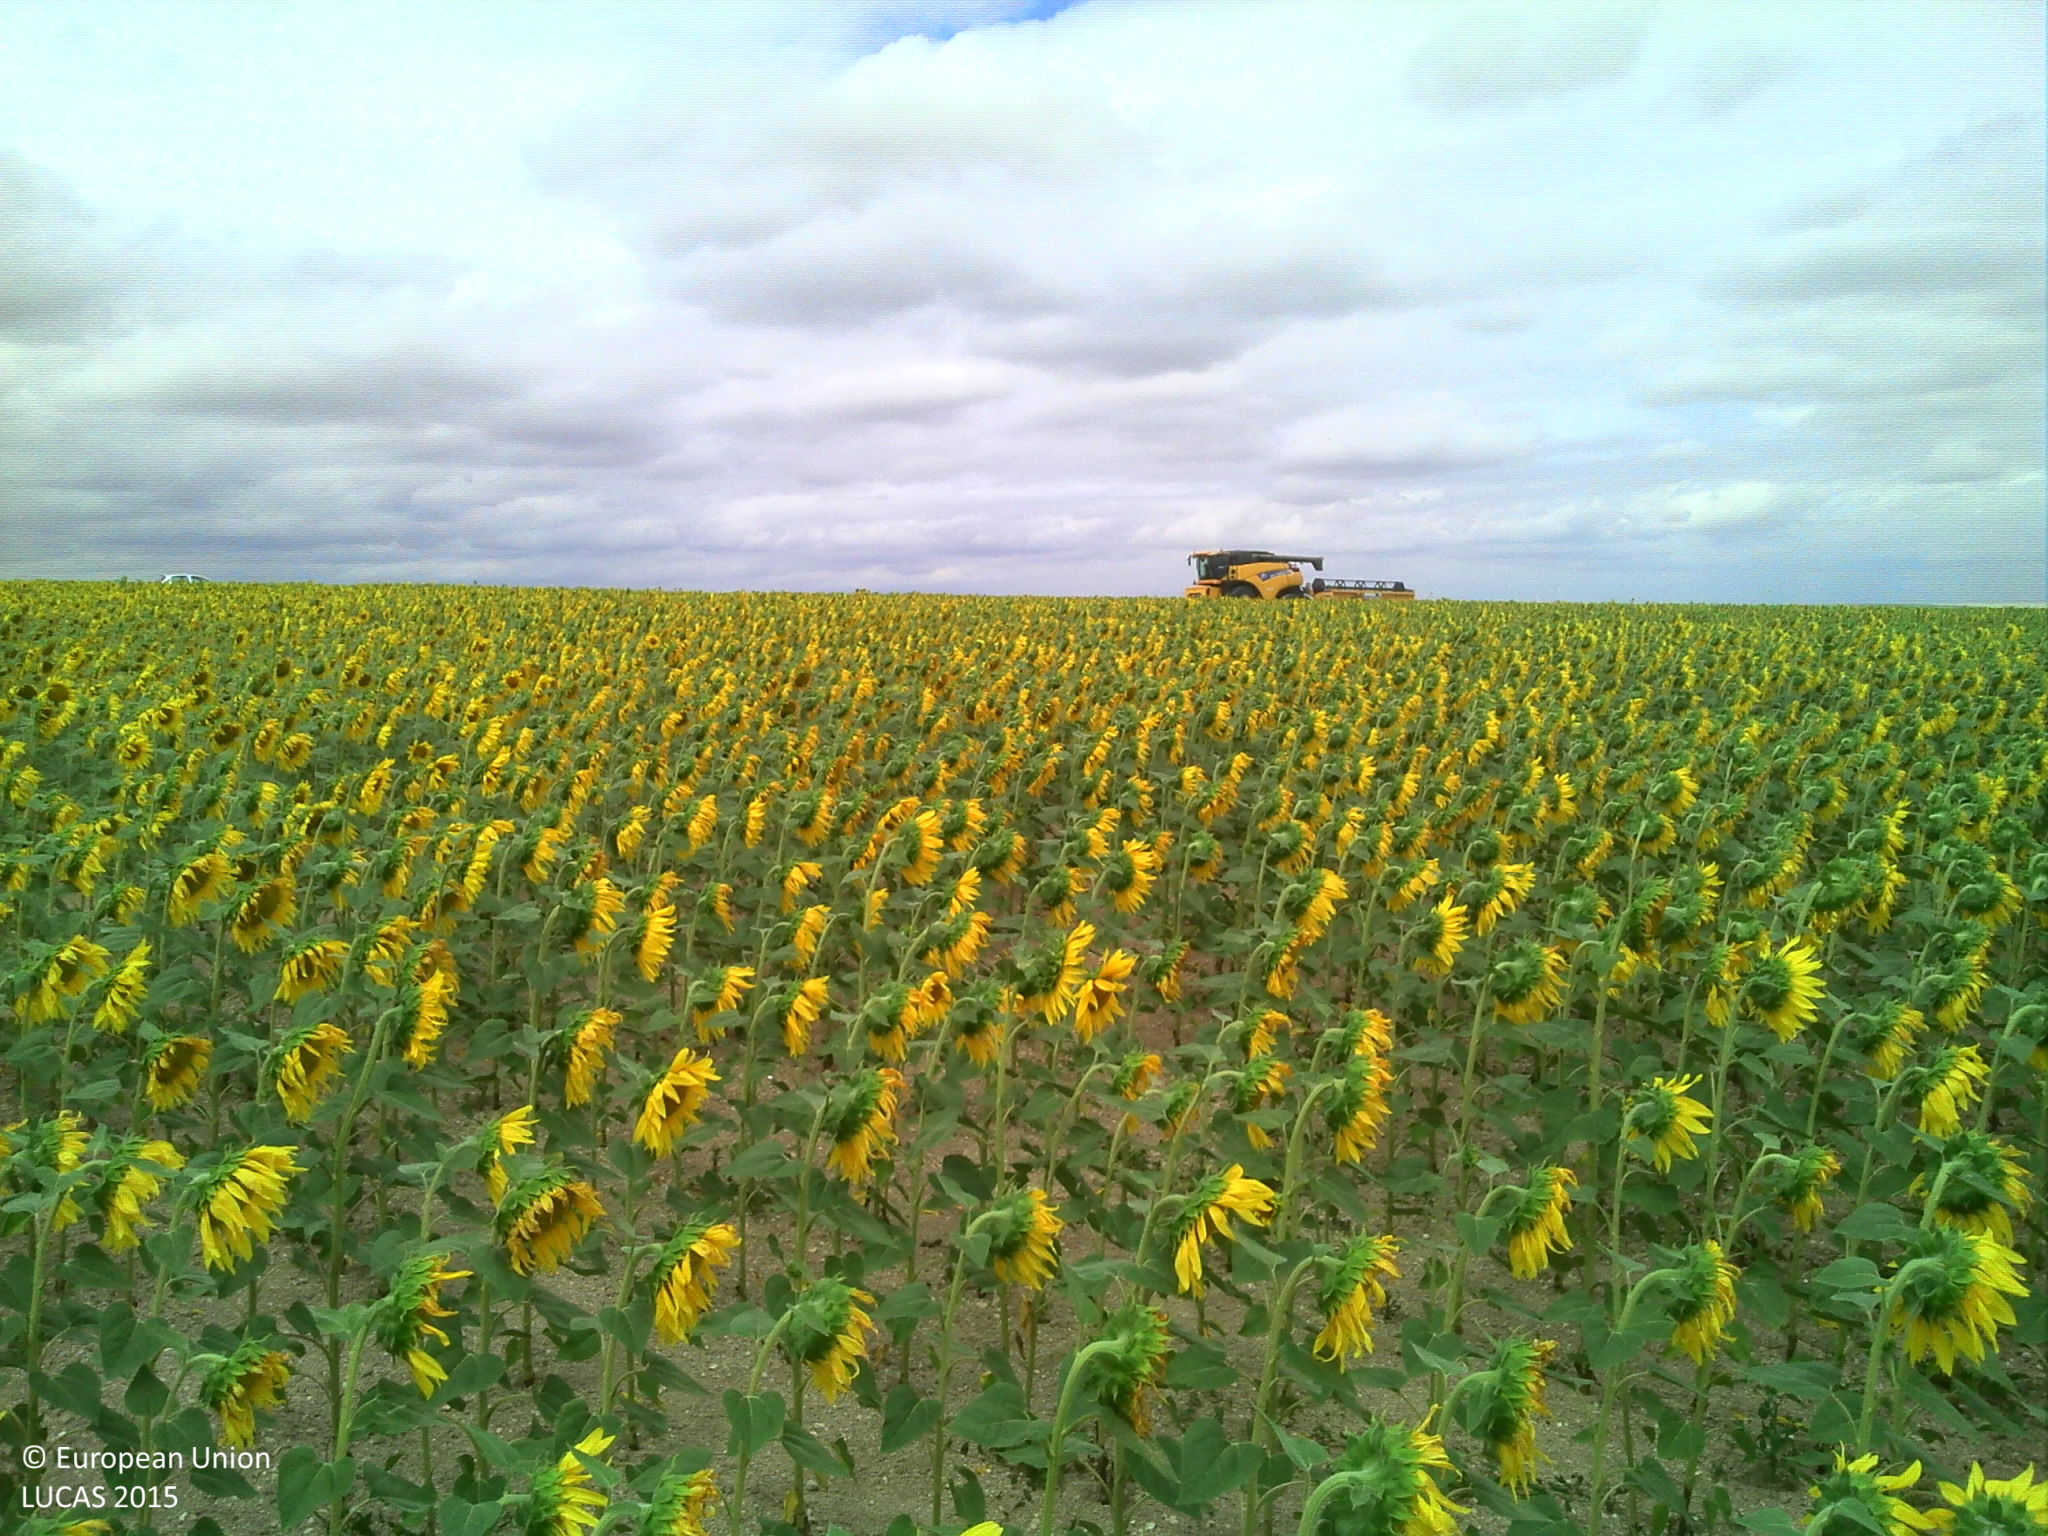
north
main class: Cropland
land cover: Sunflower
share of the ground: > 75 %
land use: Agriculture (excluding fallow land and kitchen gardens)
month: July
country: FR
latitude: 48.8274
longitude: 4.1794
